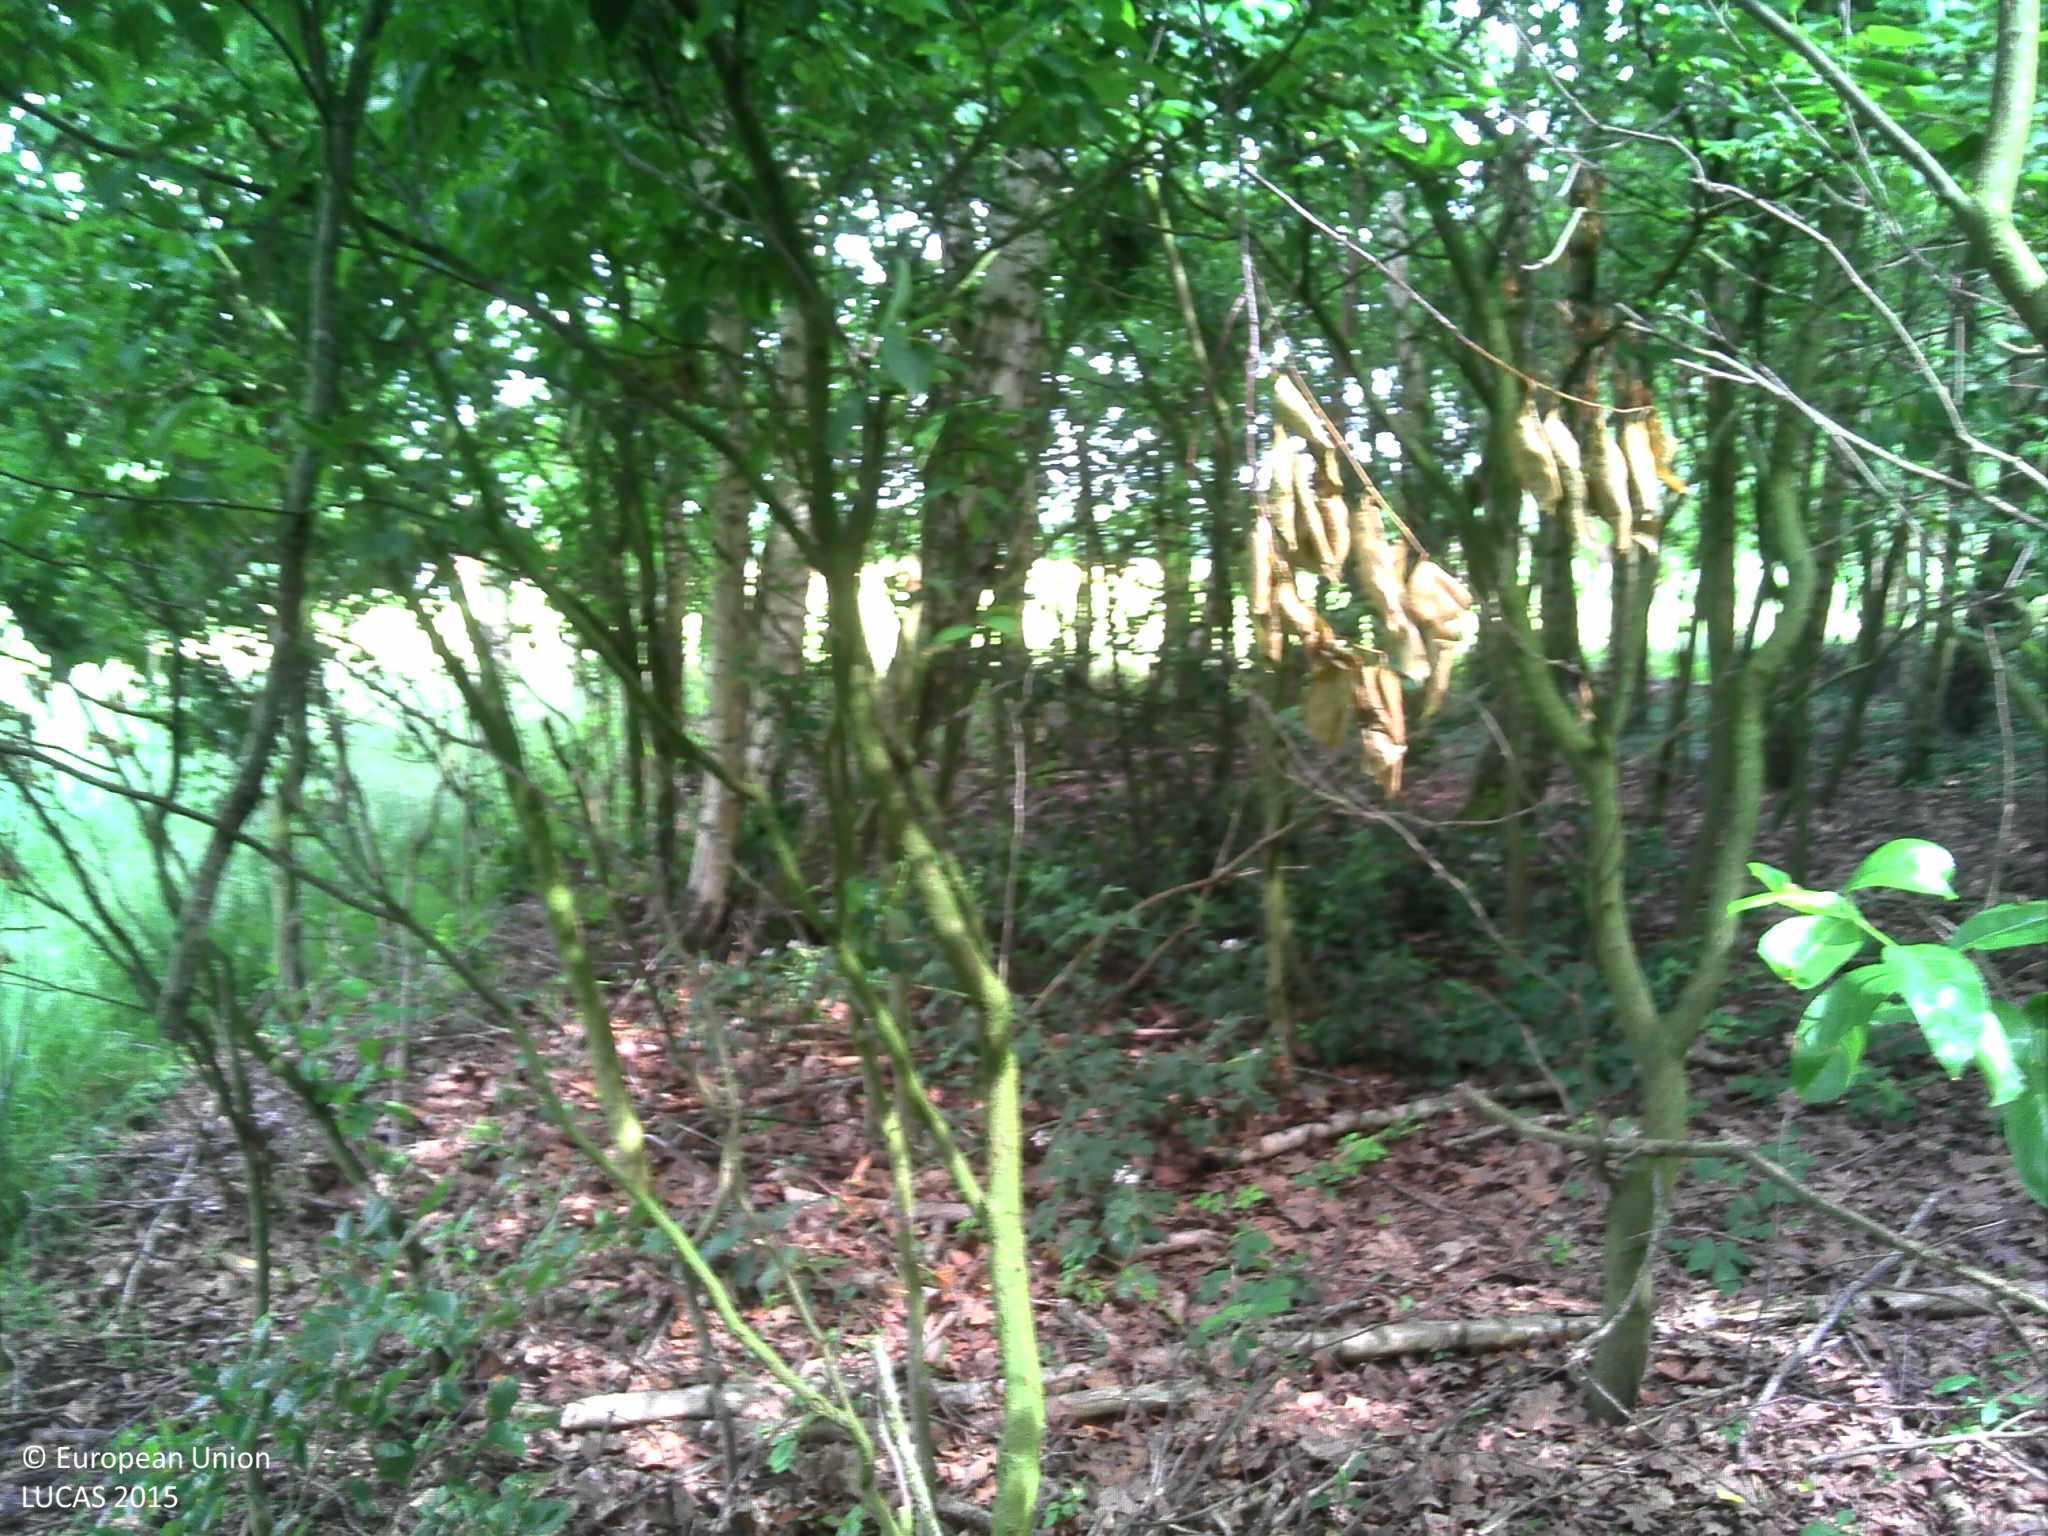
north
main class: Woodland
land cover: Broadleaved woodland
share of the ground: > 75 %
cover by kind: broadleaved forest trees 100 %
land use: Forestry
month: June
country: BE
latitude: 50.9978
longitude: 3.6234
